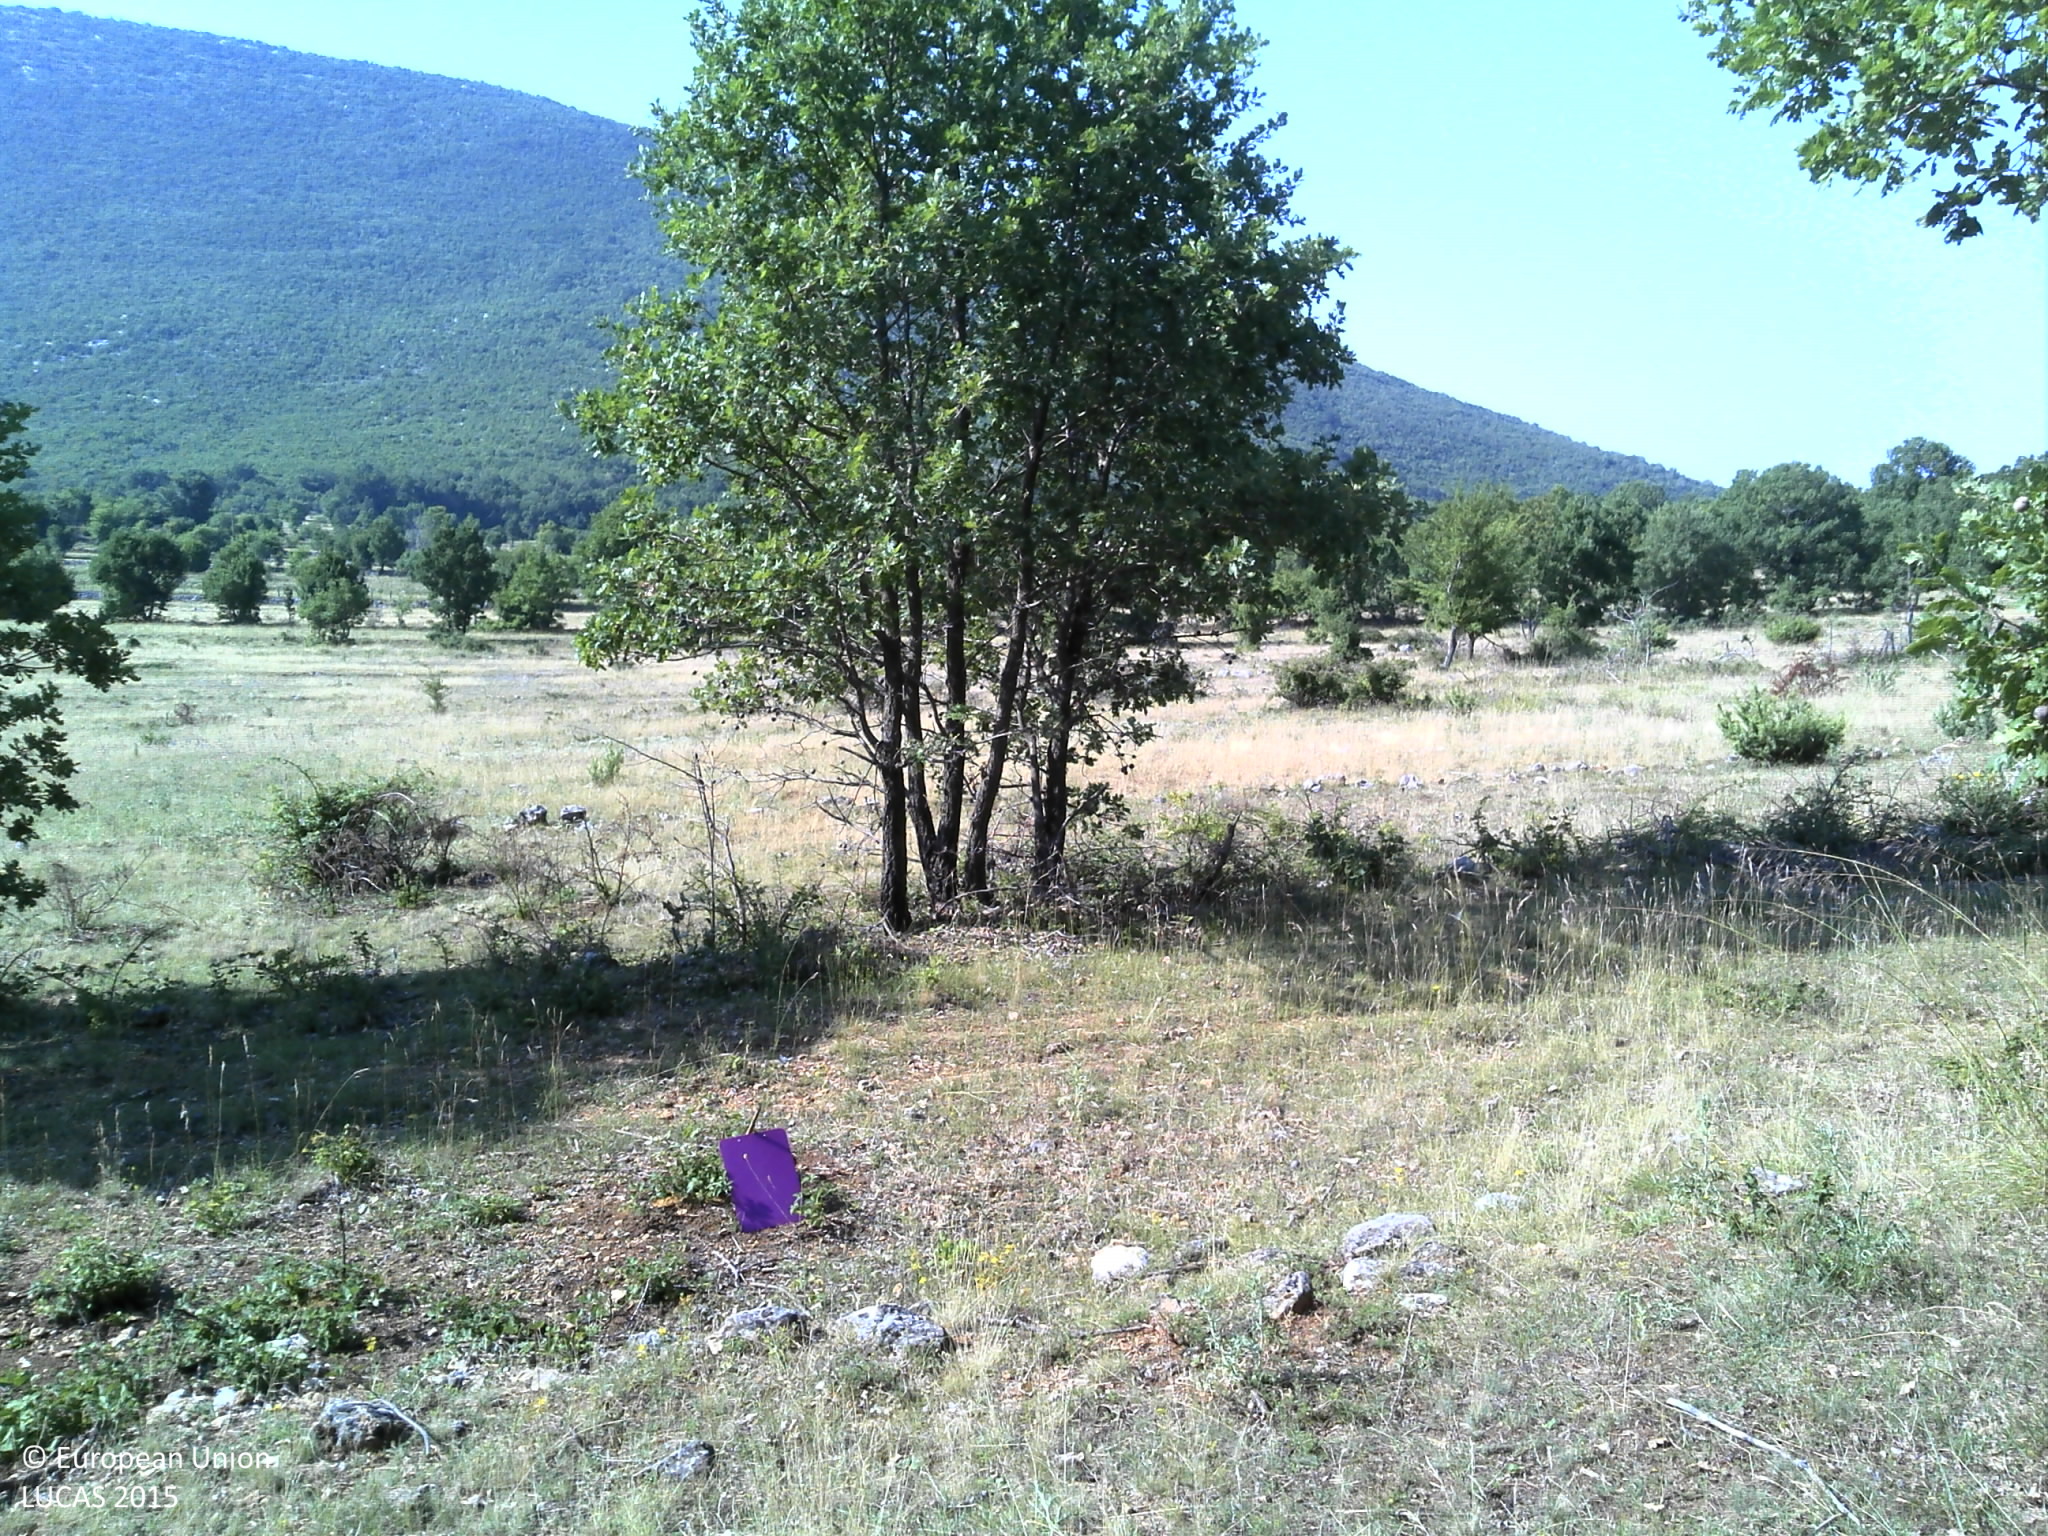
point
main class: Woodland
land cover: Broadleaved woodland
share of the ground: 25 - 50 %
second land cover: Grassland without tree/shrub cover
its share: 50 - 75 %
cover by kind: herbaceous plants 50 %, broadleaved forest trees 30 %, shrubs 20 %
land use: Forestry
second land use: Agriculture (excluding fallow land and kitchen gardens)
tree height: > 5 m
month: July
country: HR
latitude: 43.9789
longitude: 16.2880
